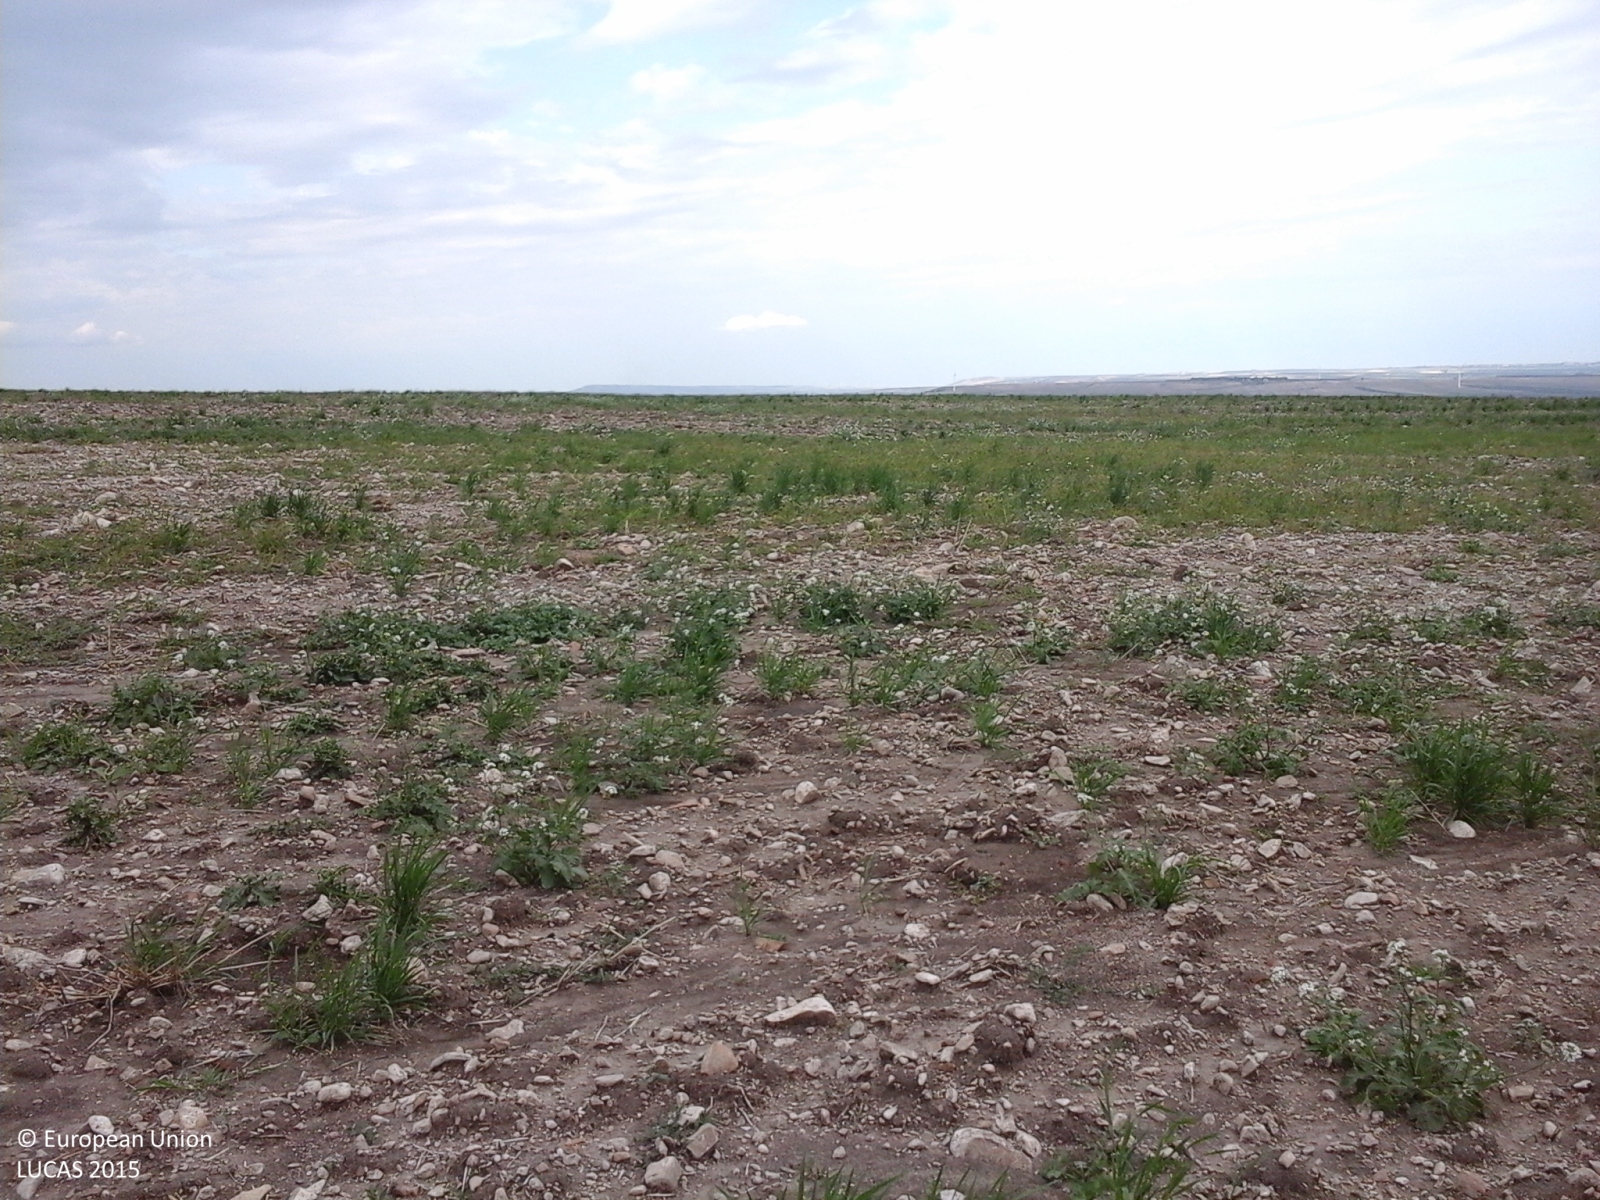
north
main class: Cropland
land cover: Durum wheat
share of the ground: > 75 %
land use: Agriculture (excluding fallow land and kitchen gardens)
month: October
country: IT
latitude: 41.5611
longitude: 15.1988
